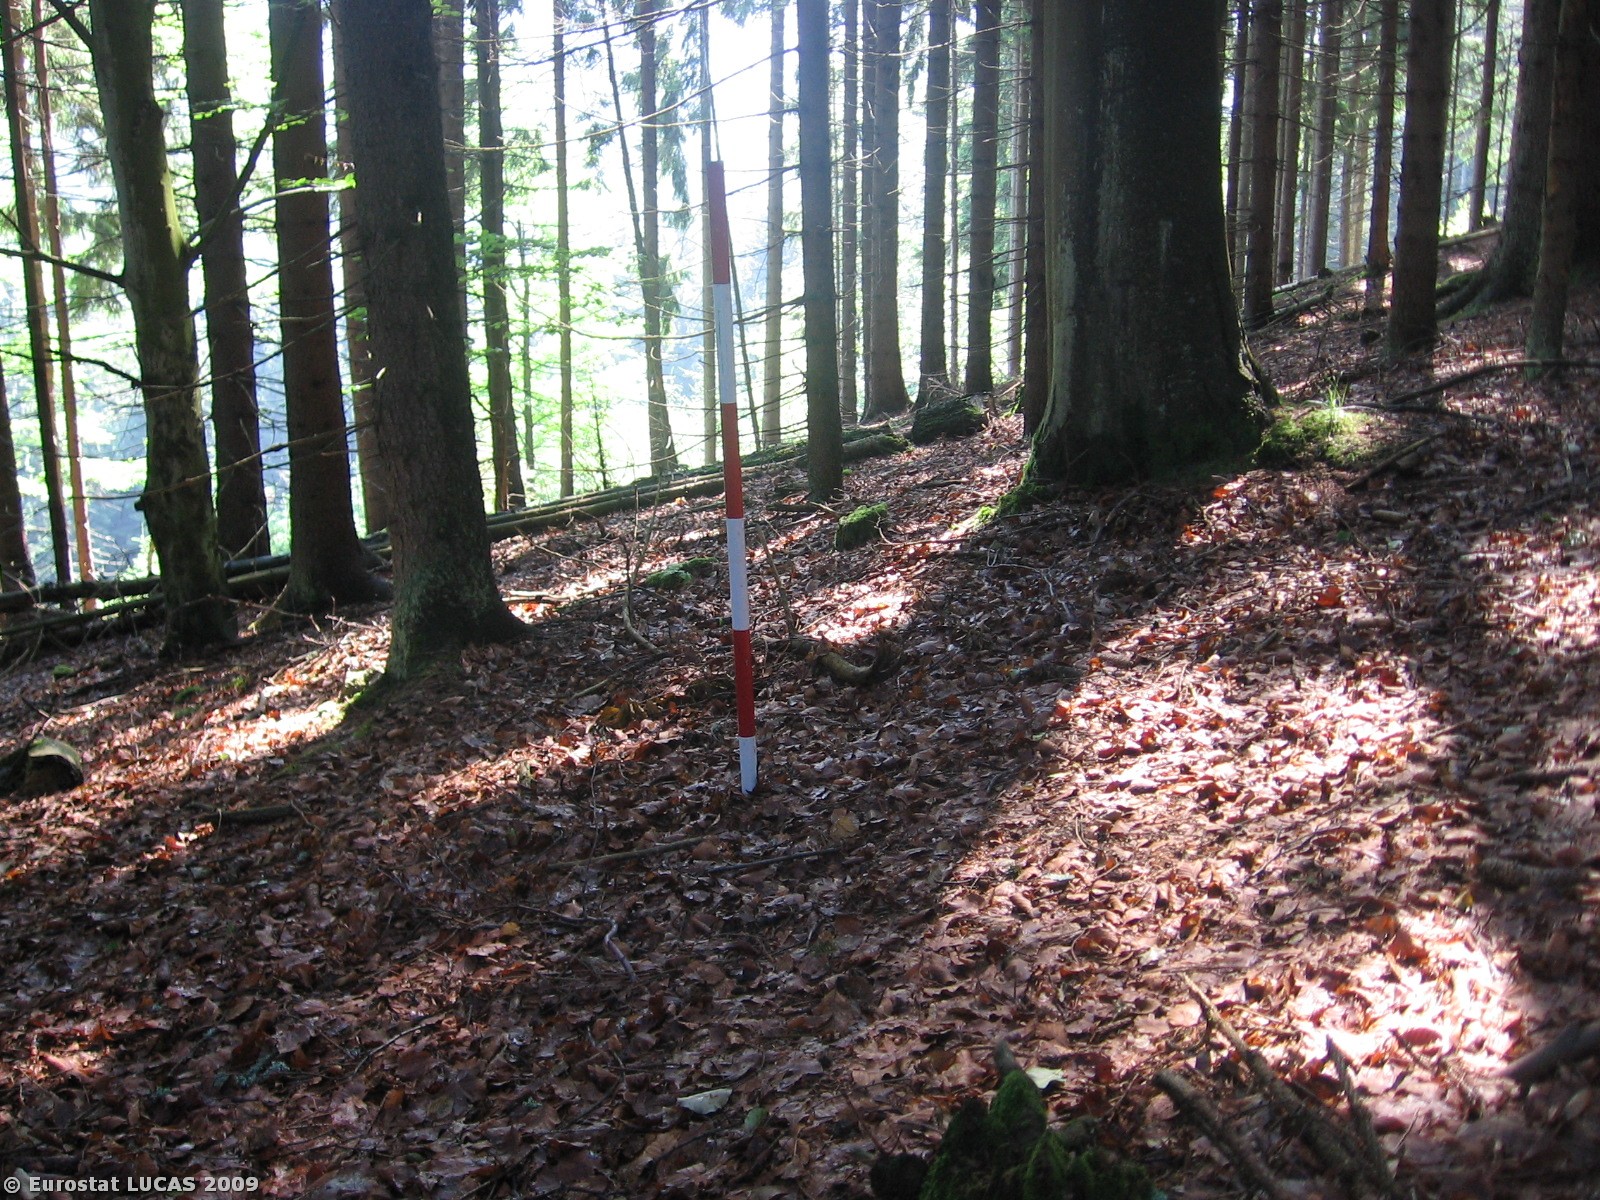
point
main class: Woodland
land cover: Coniferous woodland
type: hemiboreal forest and nemoral coniferous forest and mixed broadleaved-coniferous forest
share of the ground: > 75 %
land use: Forestry
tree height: > 5 m
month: July
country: CZ
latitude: 49.2222
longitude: 13.1715
